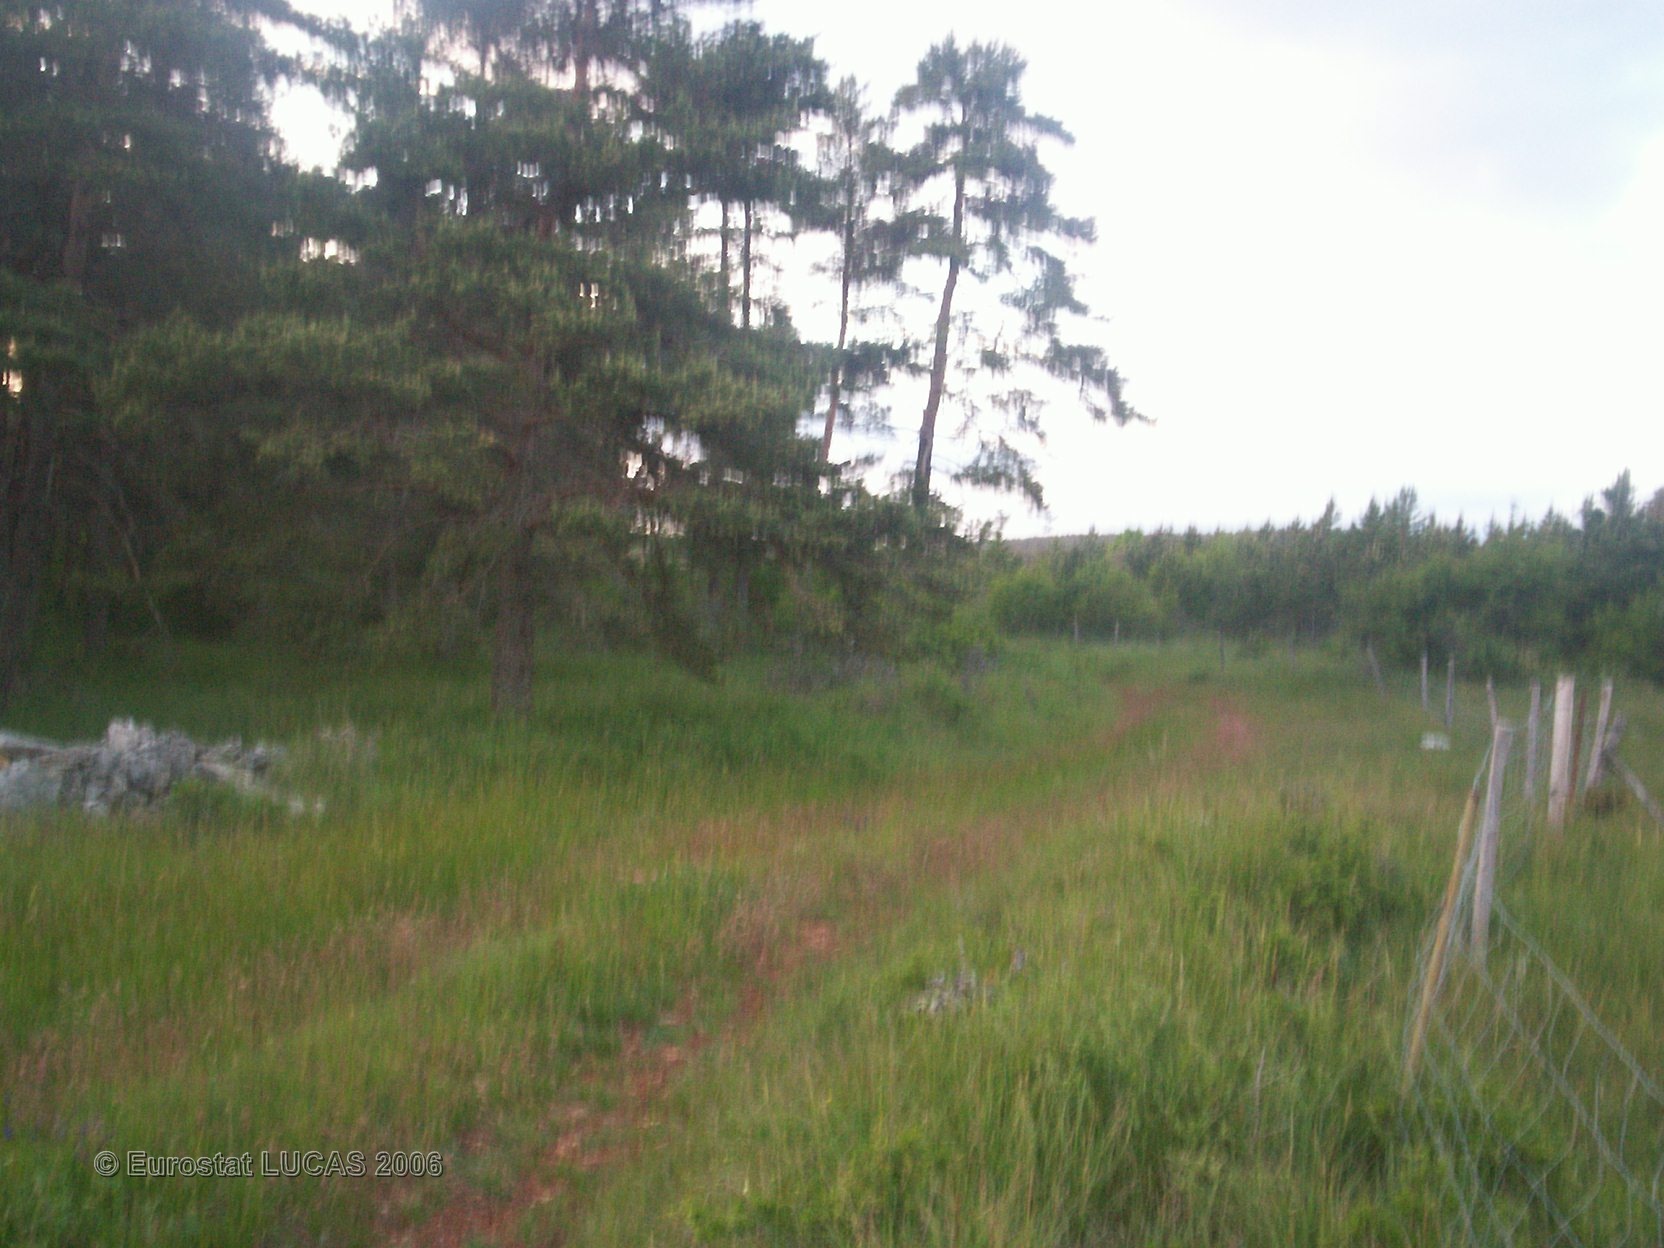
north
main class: Grassland
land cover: Grassland without tree/shrub cover
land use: Agriculture (excluding fallow land and kitchen gardens)
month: June
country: FR
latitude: 44.4484
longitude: 3.4082
